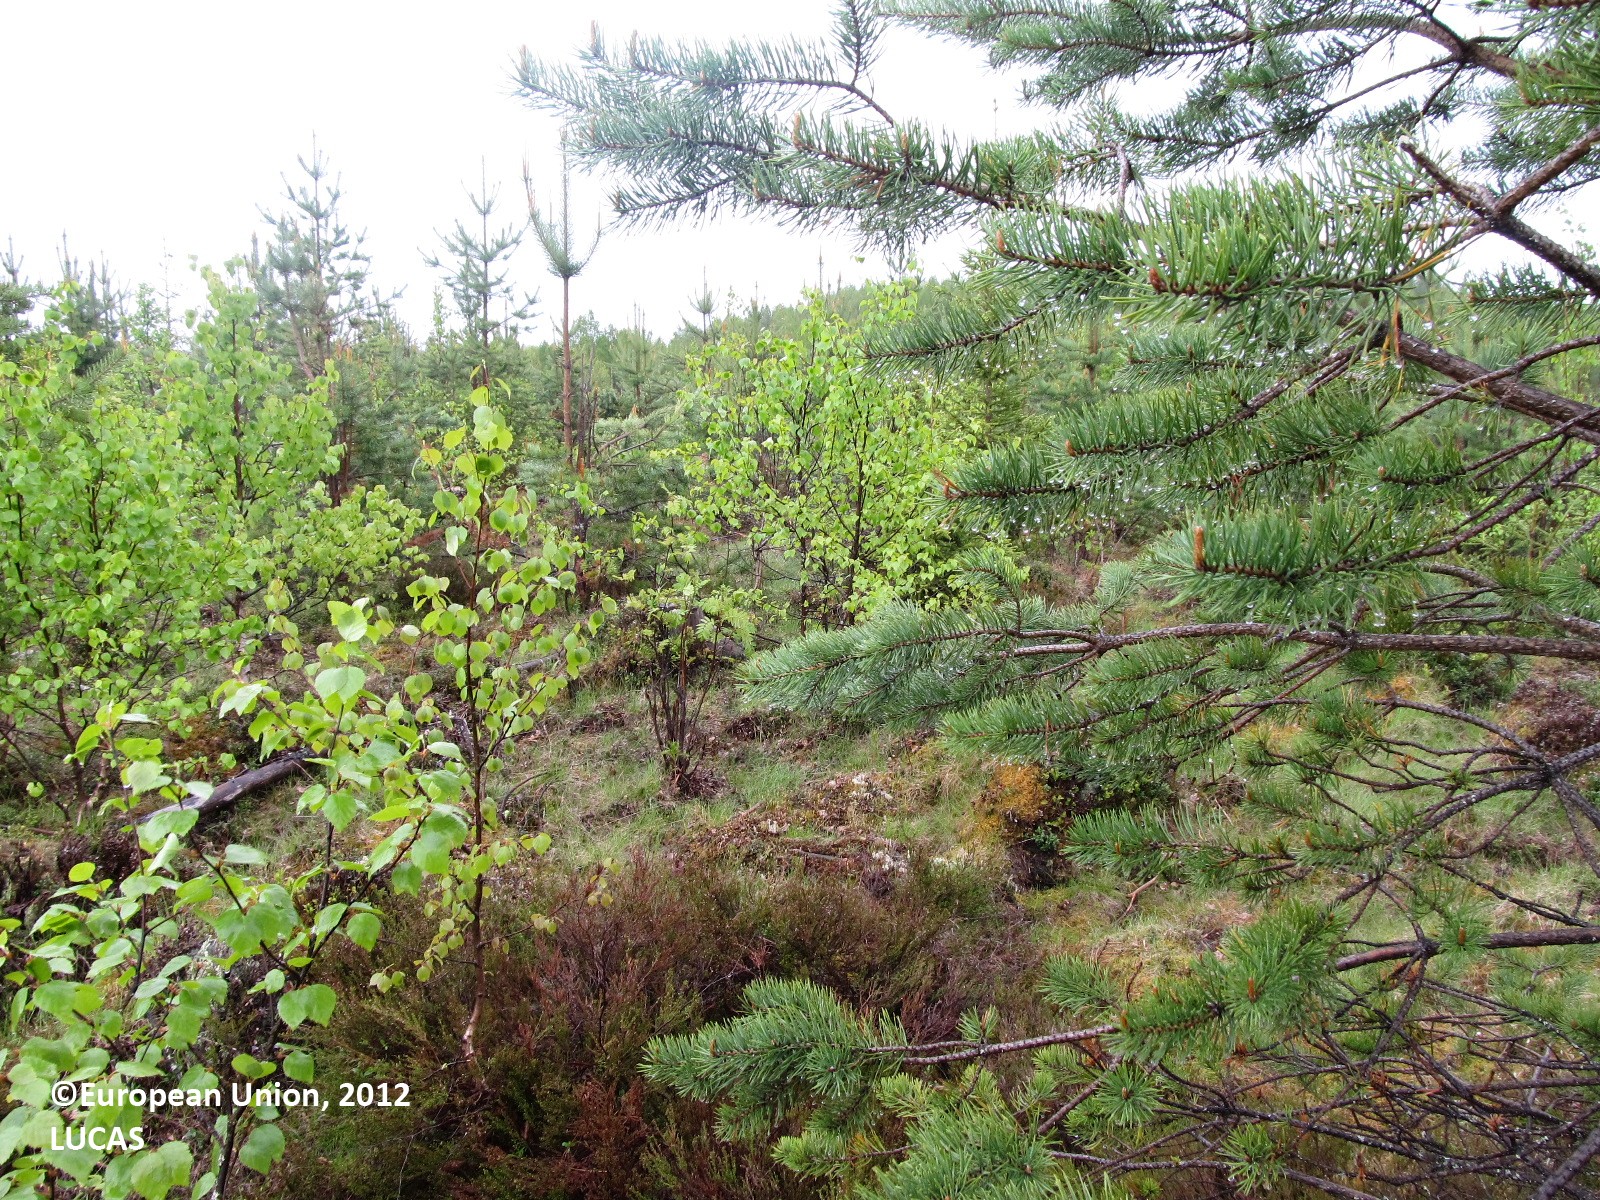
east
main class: Woodland
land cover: Pine dominated mixed woodland
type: boreal forest
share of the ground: 10 - 25 %
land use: Forestry
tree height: < 5 m
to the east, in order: Pine dominated mixed woodland; Other bare soil; Pine dominated coniferous woodland; Broadleaved woodland; Ditches and canals; Pine dominated coniferous woodland; Tracks; Pine dominated coniferous woodland; Shrubland with sparse tree cover; Tracks; Shrubland with sparse tree cover; Ditches and canals; Shrubland with sparse tree cover; Tracks; Shrubland with sparse tree cover; Pine dominated coniferous woodland
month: June
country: FI
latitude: 63.3102
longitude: 28.8220
